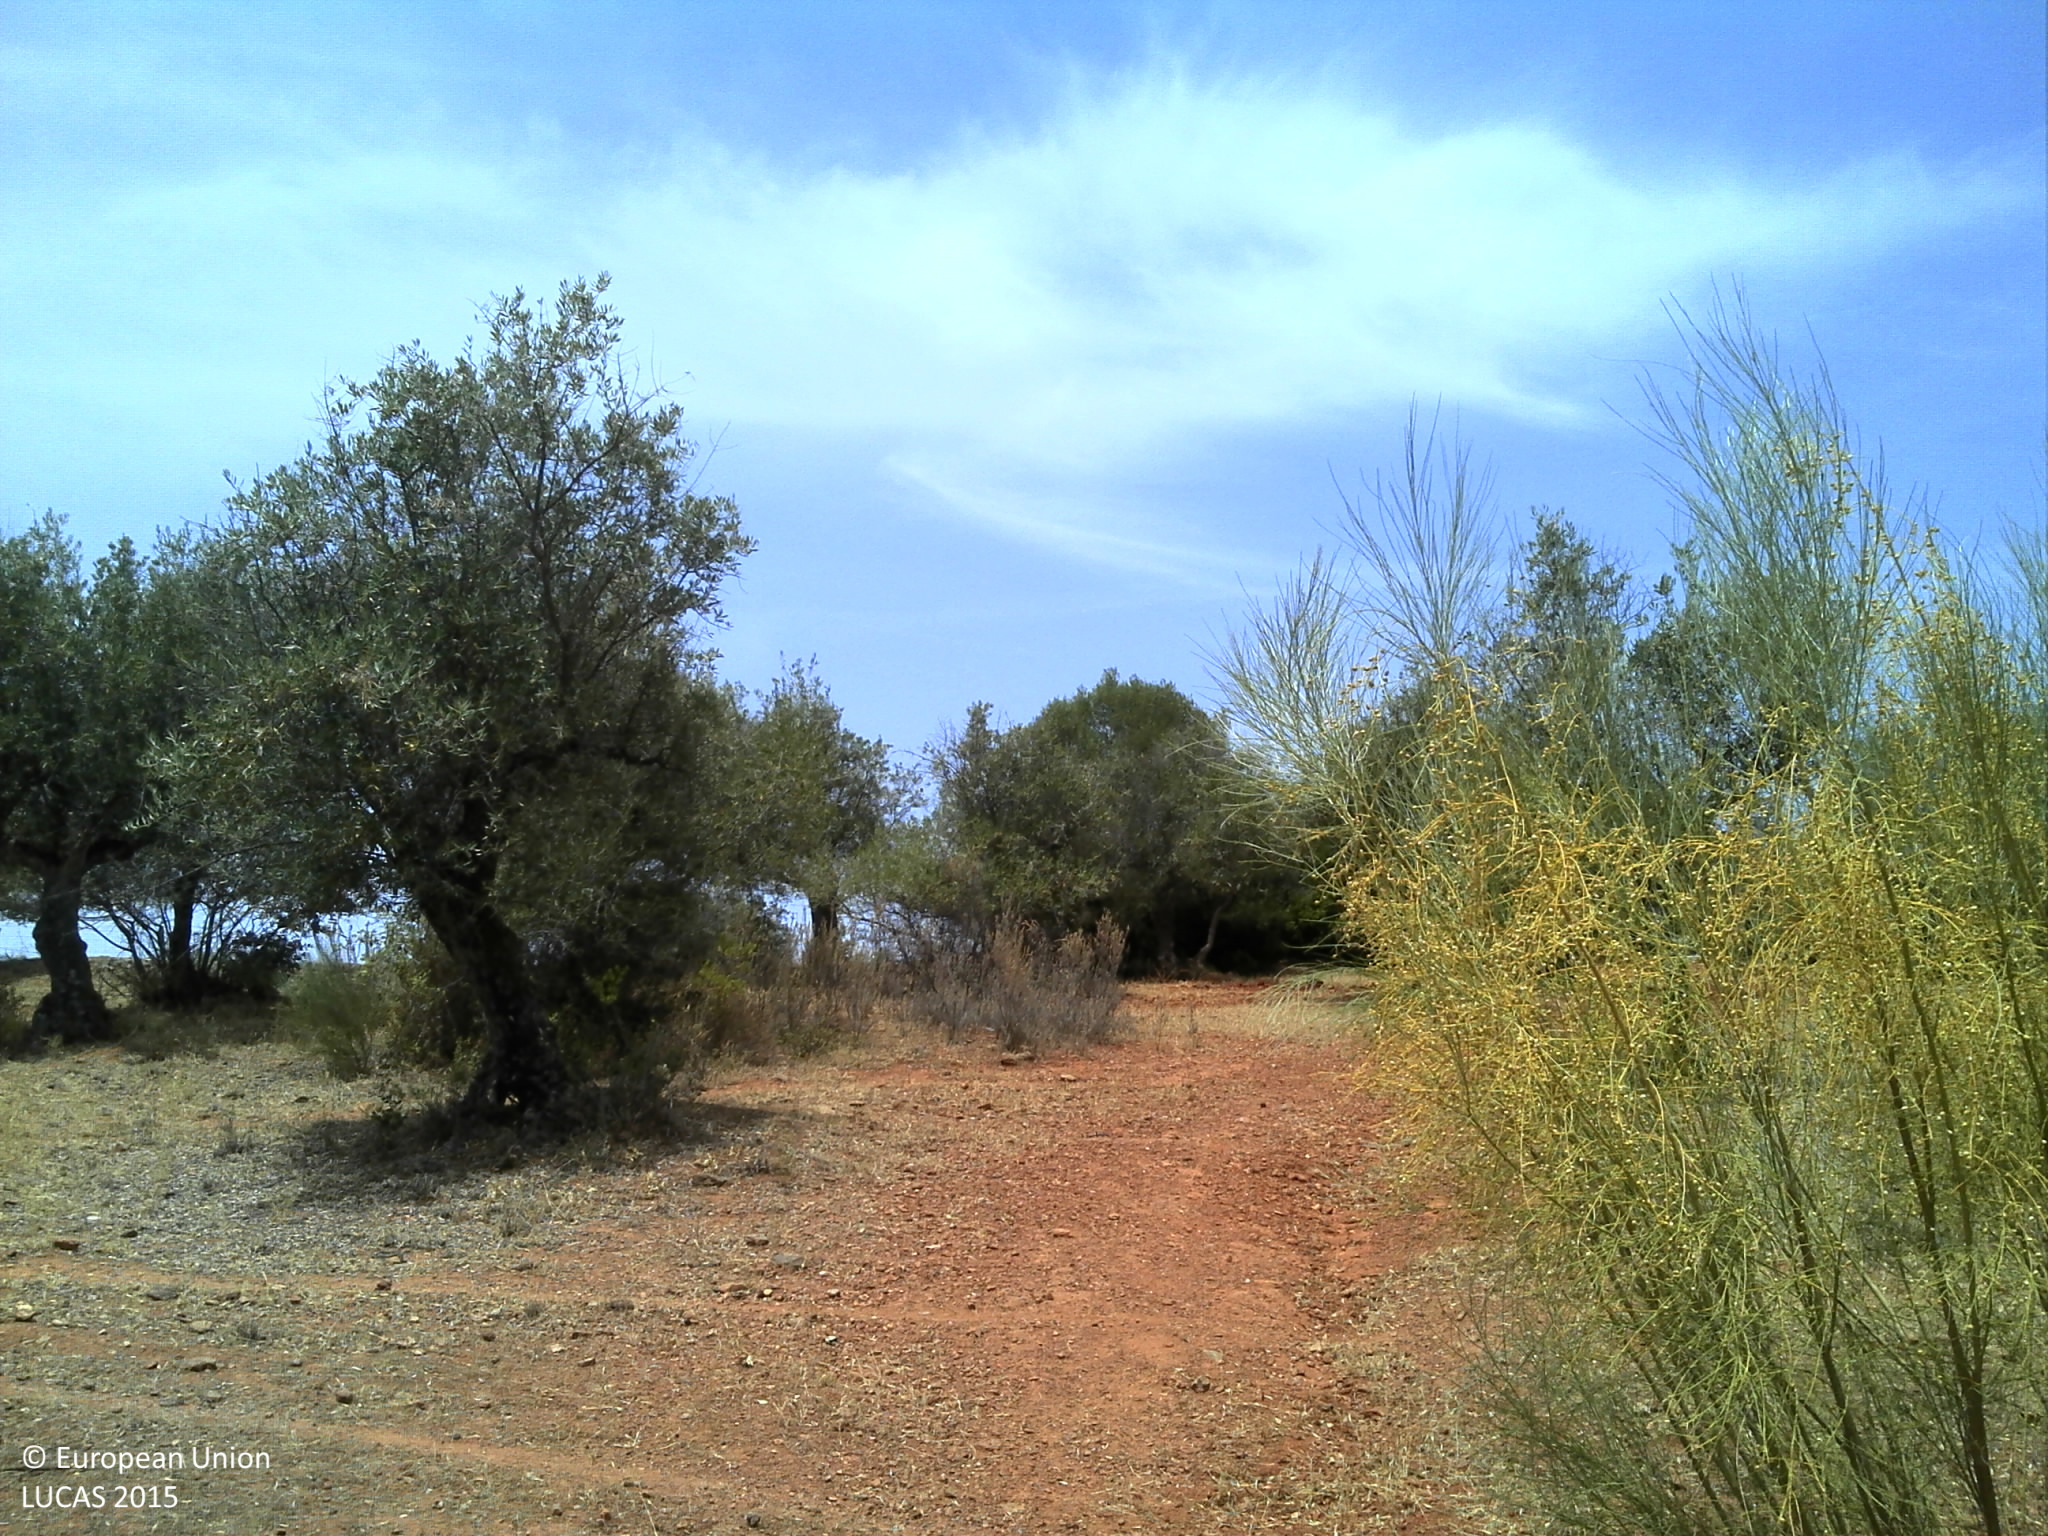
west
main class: Cropland
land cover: Olive groves
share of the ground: 25 - 50 %
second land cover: Grassland without tree/shrub cover
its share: 25 - 50 %
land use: Agriculture (excluding fallow land and kitchen gardens)
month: July
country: PT
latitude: 38.2231
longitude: -7.6754
